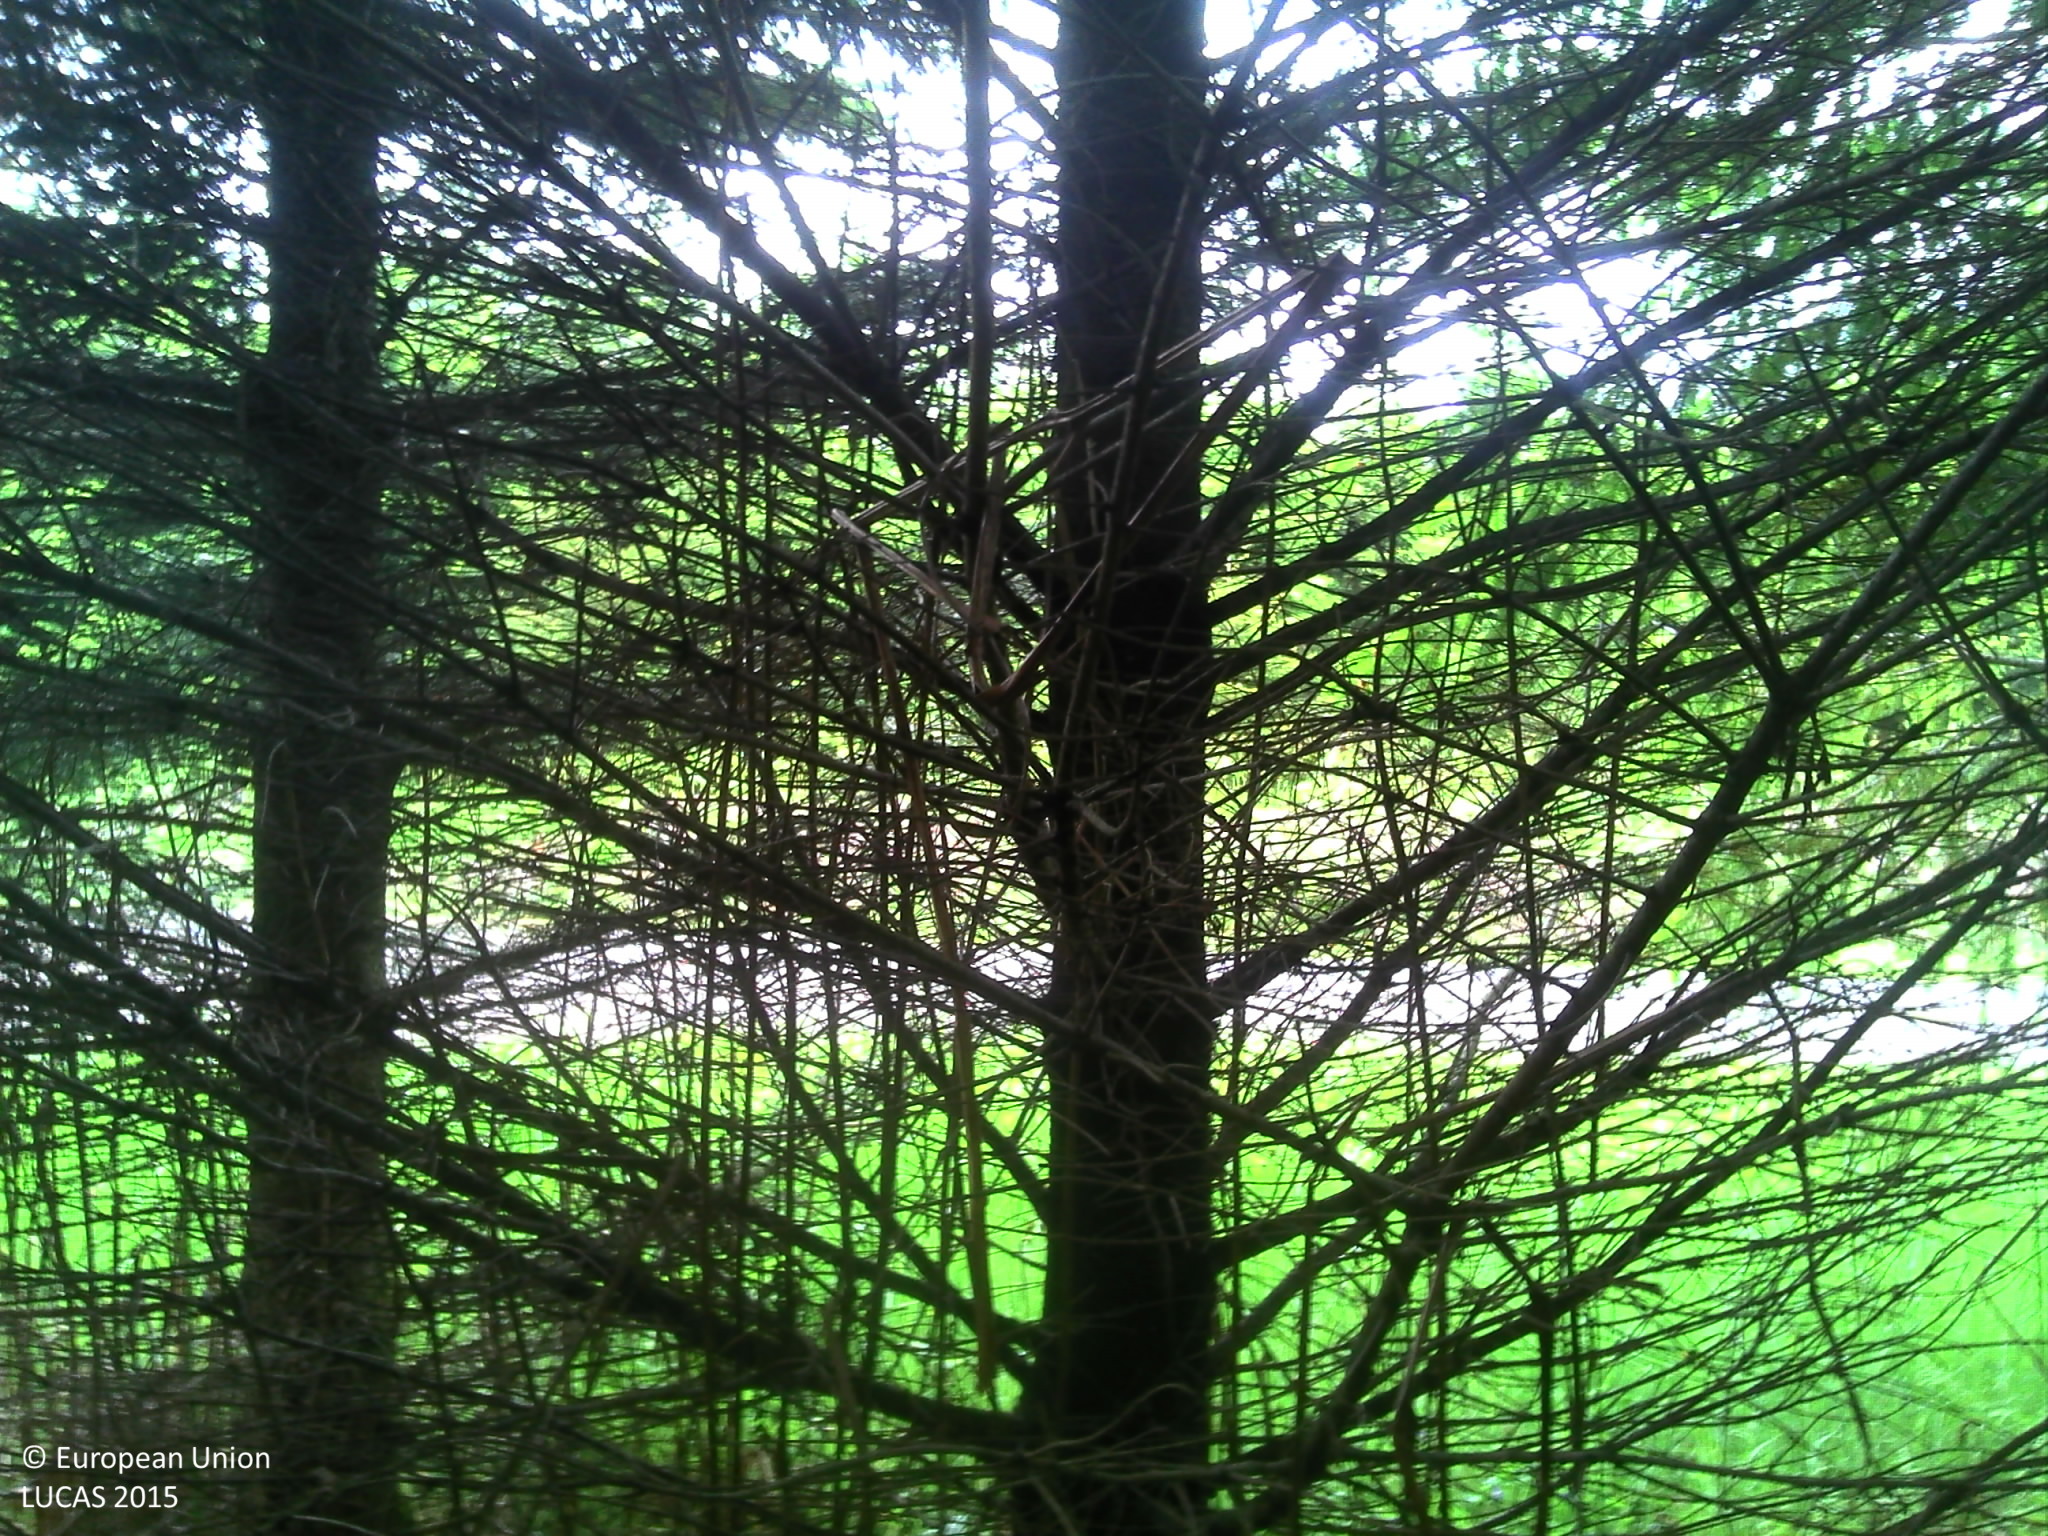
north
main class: Woodland
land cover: Spruce dominated coniferous woodland
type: exotic forest
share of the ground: > 75 %
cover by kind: coniferous forest trees 85 %, herbaceous plants 15 %
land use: Forestry
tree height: > 5 m
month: June
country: BE
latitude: 49.9420
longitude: 4.8552
